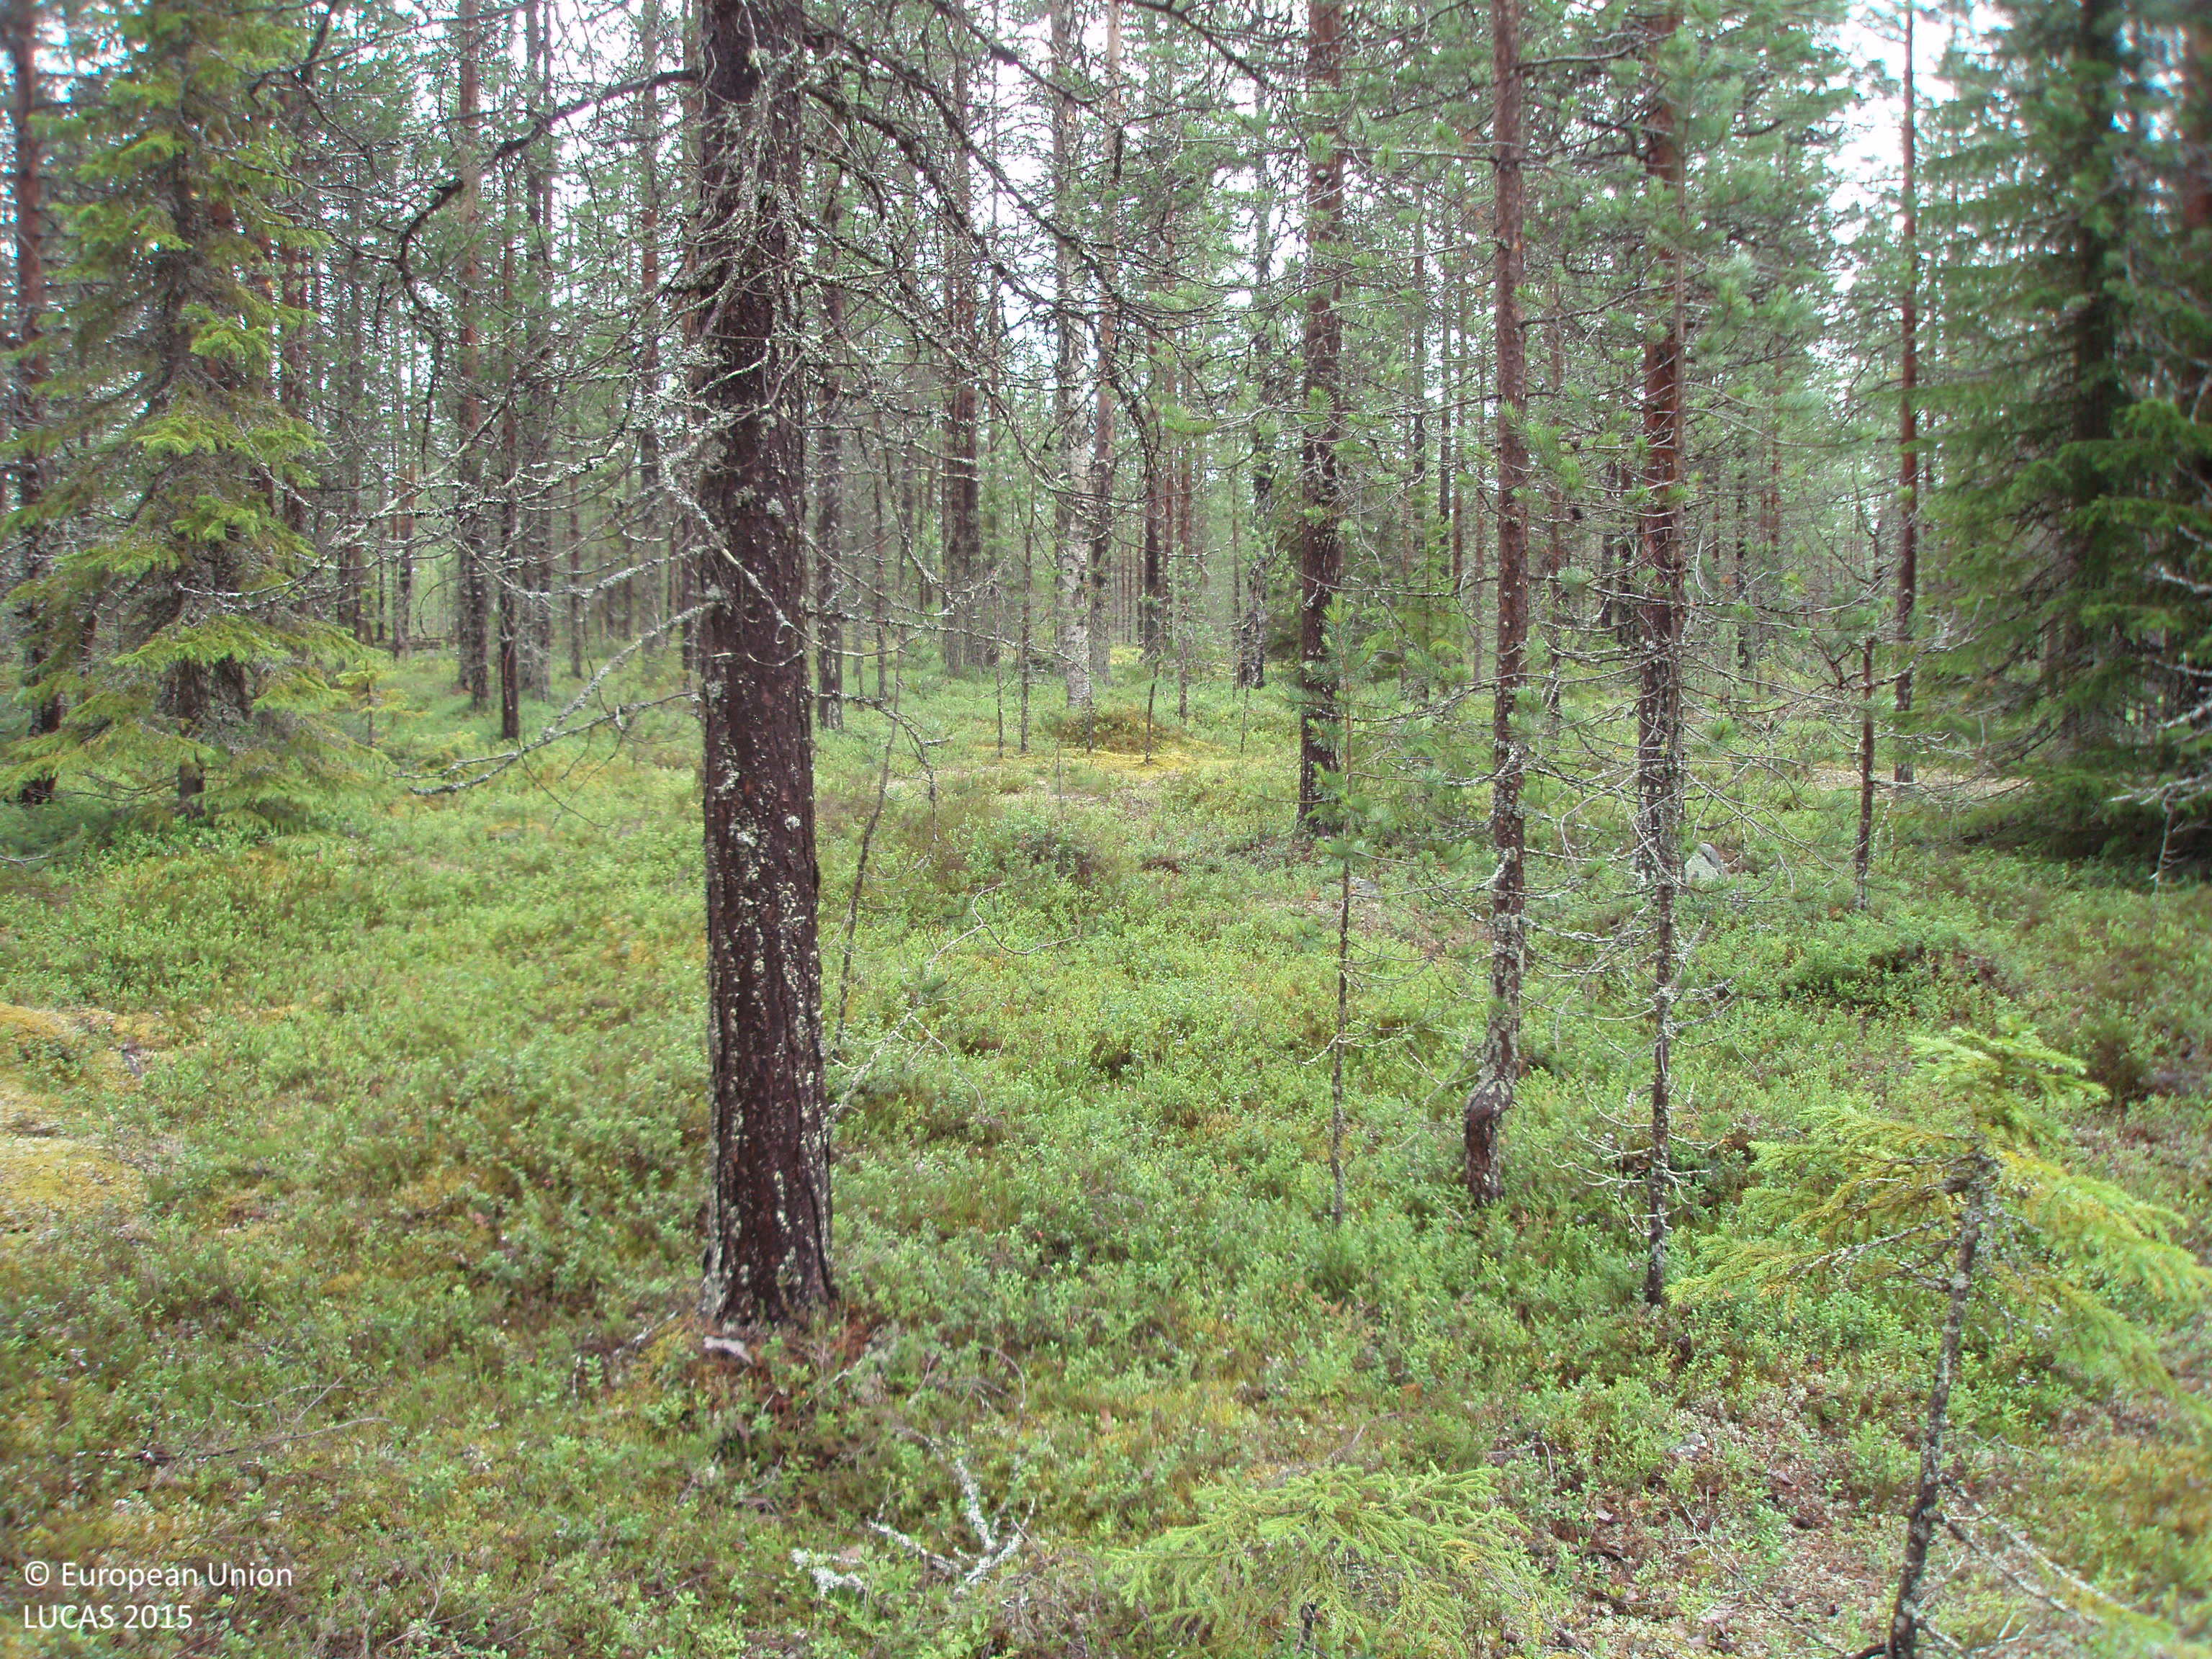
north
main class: Woodland
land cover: Pine dominated coniferous woodland
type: boreal forest
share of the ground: 50 - 75 %
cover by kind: coniferous forest trees 70 %, shrubs 30 %
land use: Forestry
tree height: > 5 m
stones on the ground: 25 - 50 %
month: July
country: FI
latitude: 66.0339
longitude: 28.0762
